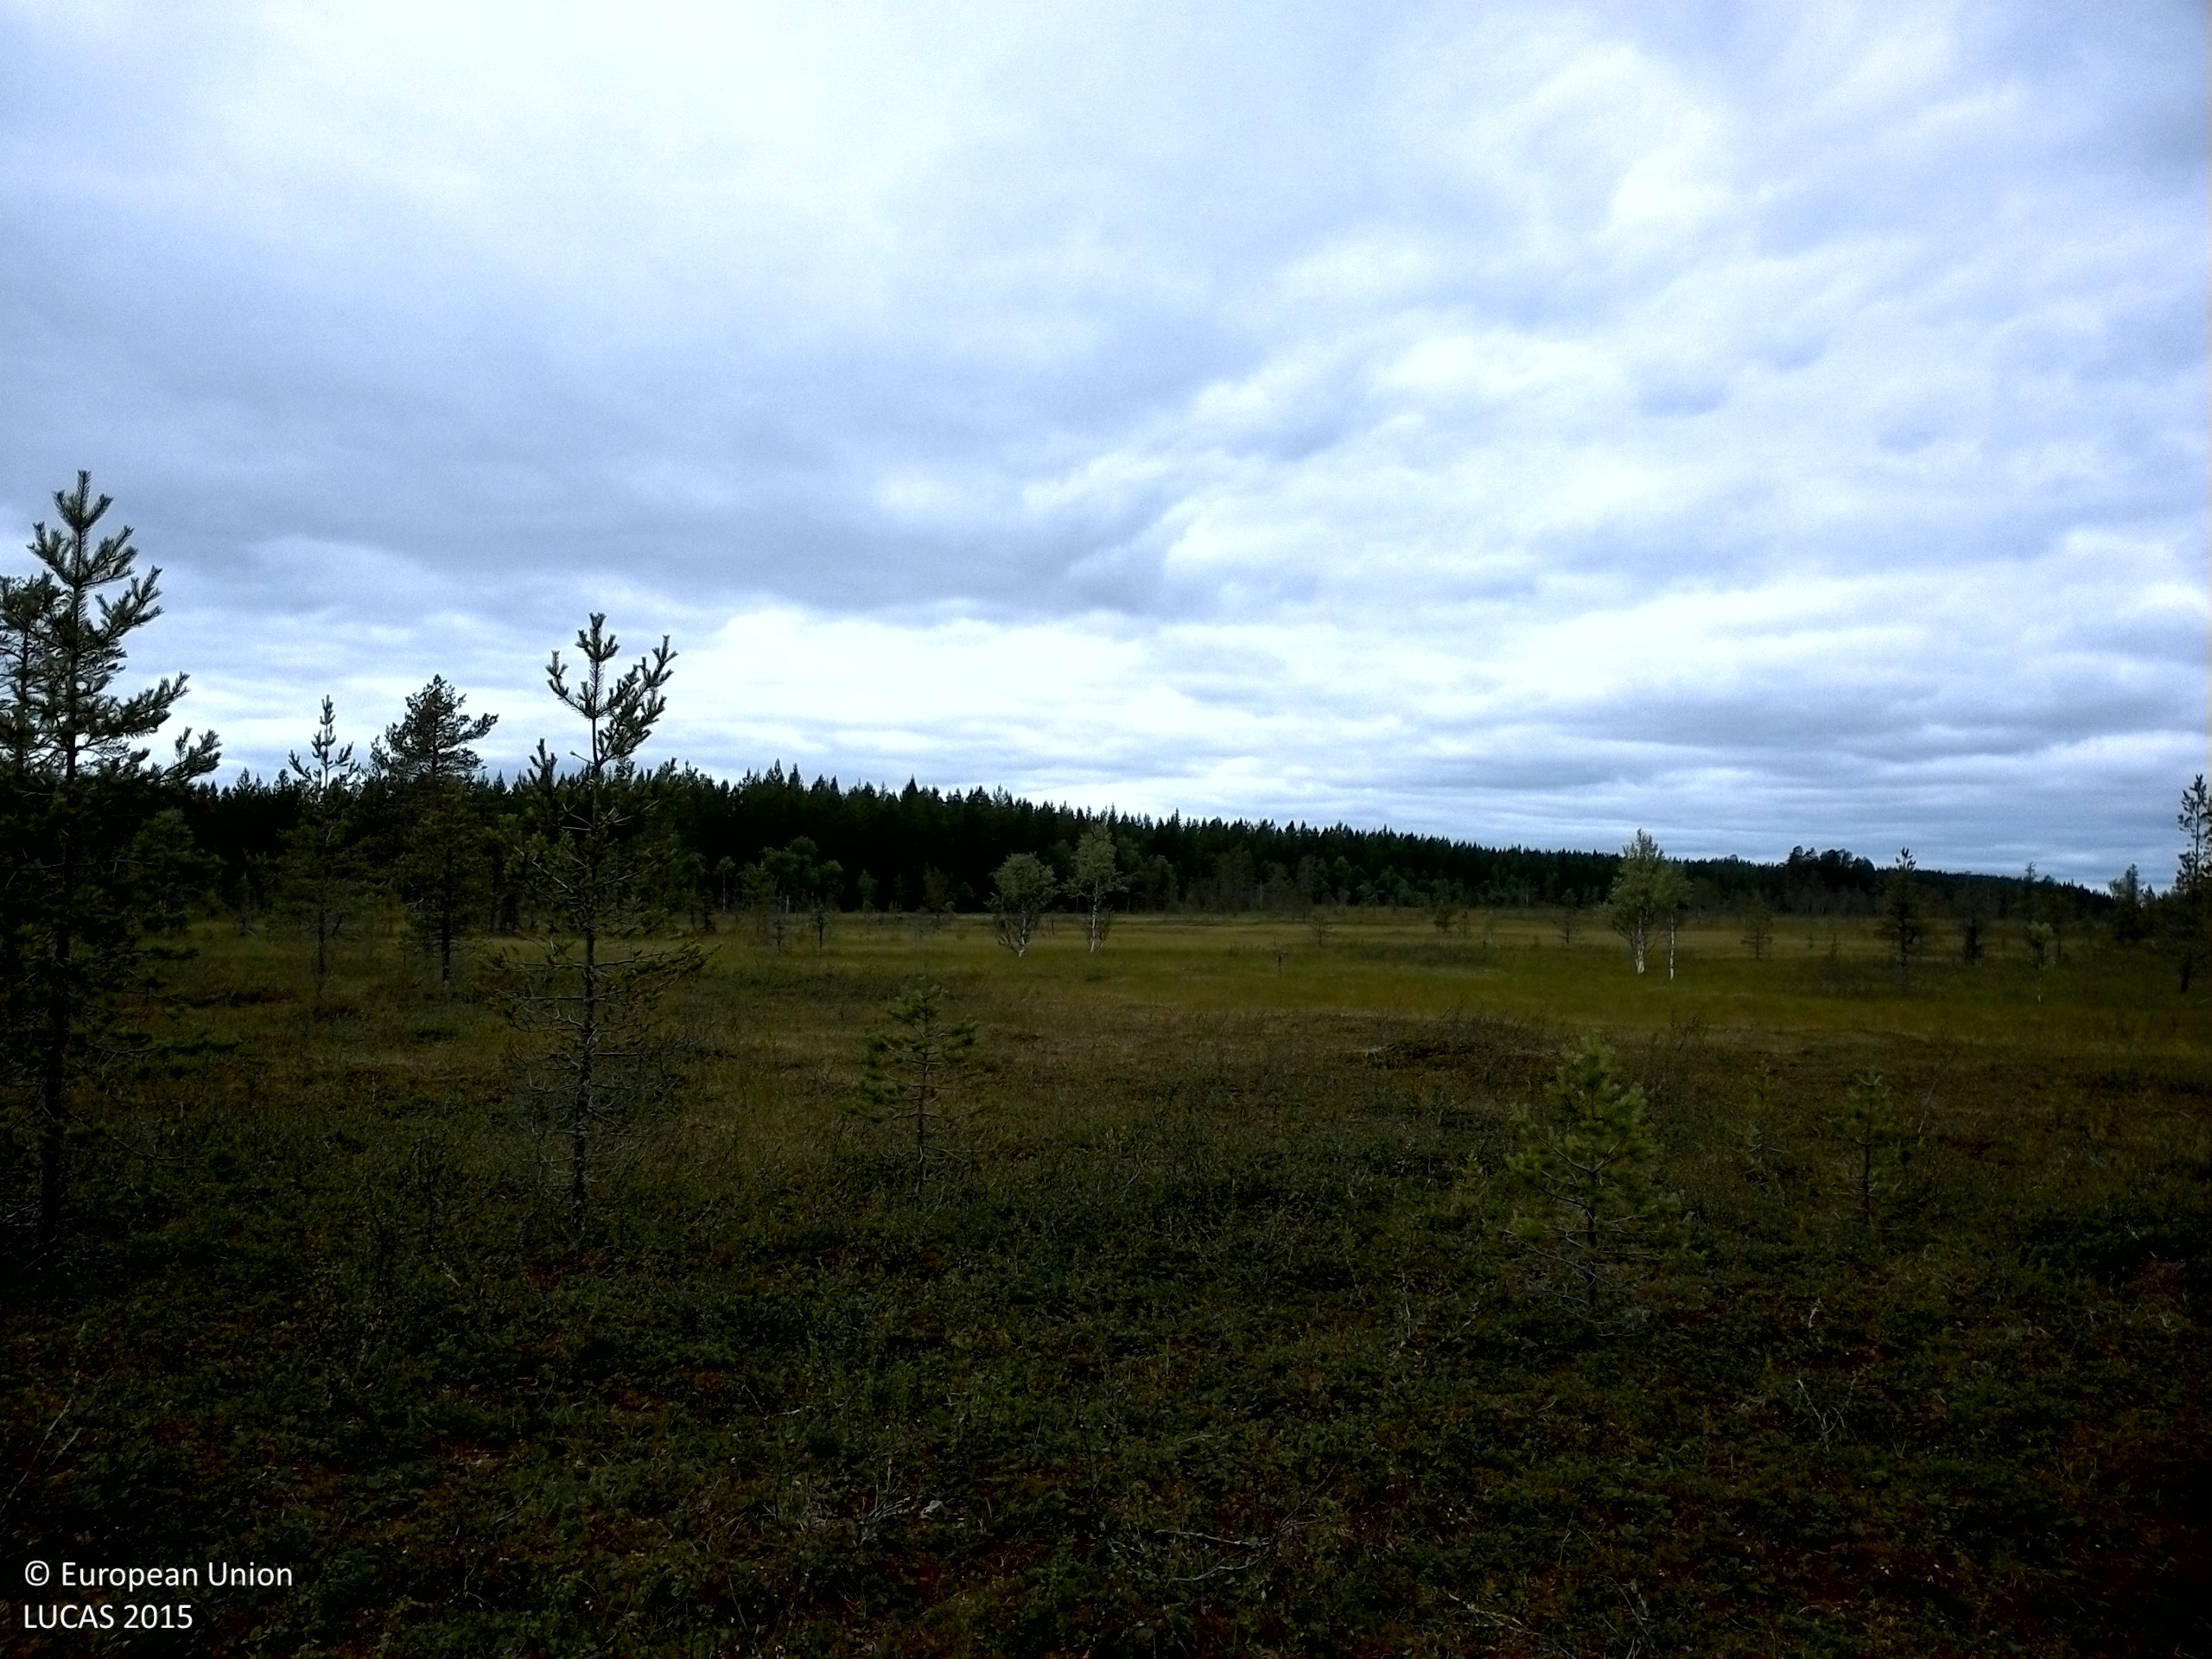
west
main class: Woodland
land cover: Pine dominated coniferous woodland
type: boreal forest
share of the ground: 10 - 25 %
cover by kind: lichens and mosses 40 %, shrubs 35 %, coniferous forest trees 15 %, herbaceous plants 10 %
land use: Forestry
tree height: < 5 m
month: August
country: SE
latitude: 62.8752
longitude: 17.1927
